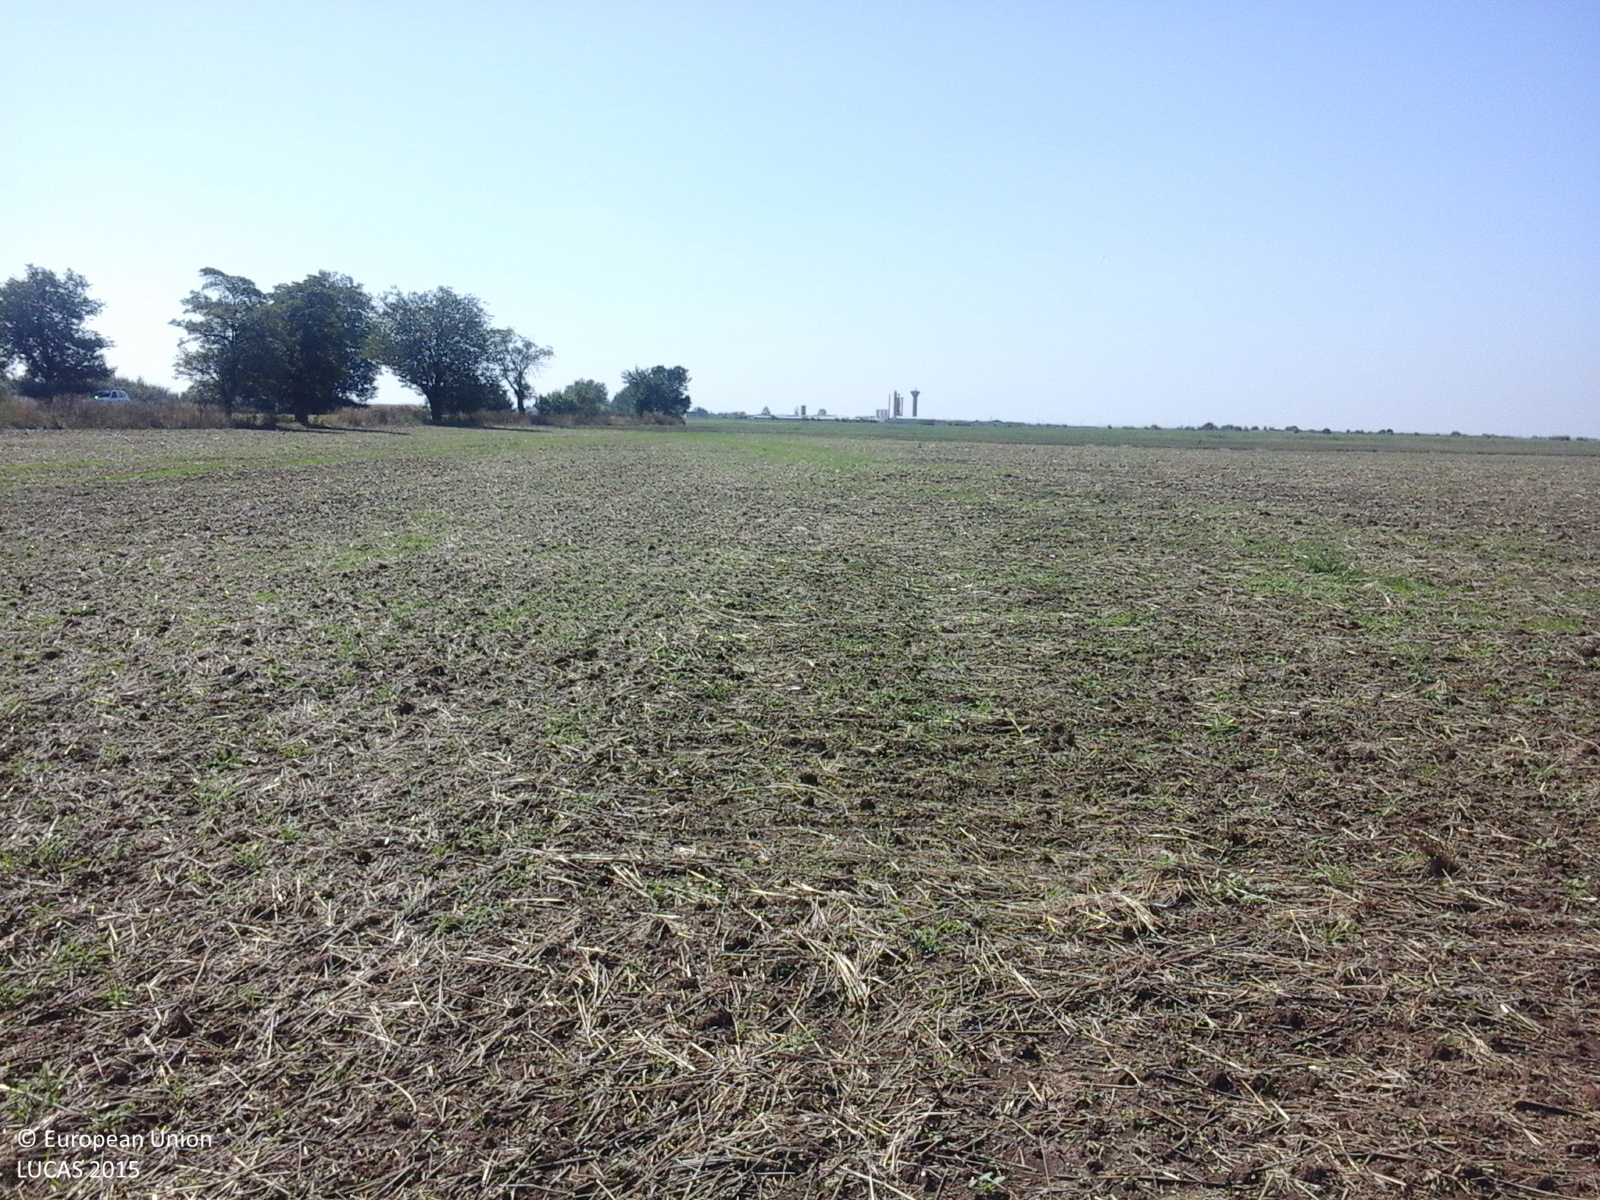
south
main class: Cropland
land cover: Common wheat
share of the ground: 10 - 25 %
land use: Agriculture (excluding fallow land and kitchen gardens)
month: August
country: RO
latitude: 45.8879
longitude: 21.2035
